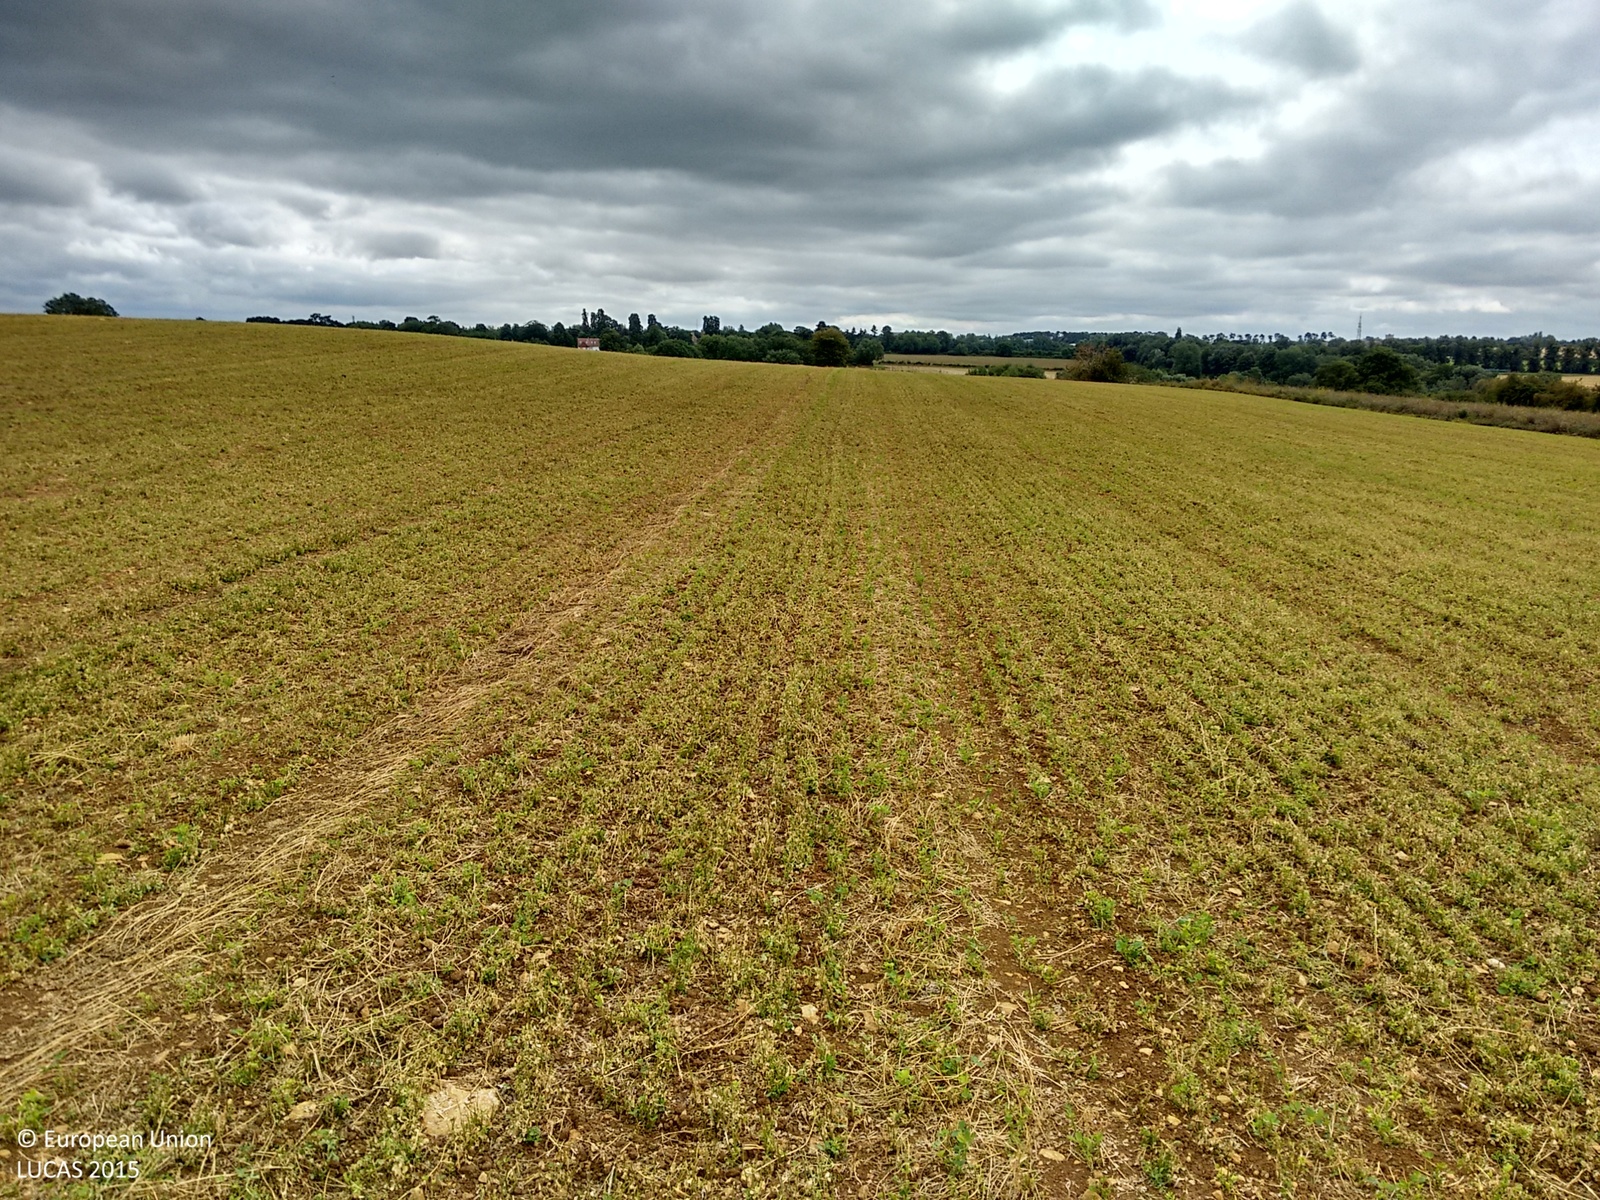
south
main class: Cropland
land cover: Dry pulses
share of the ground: 10 - 25 %
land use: Agriculture (excluding fallow land and kitchen gardens)
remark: Harvested field
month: August
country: GB
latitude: 52.2933
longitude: -0.8780
